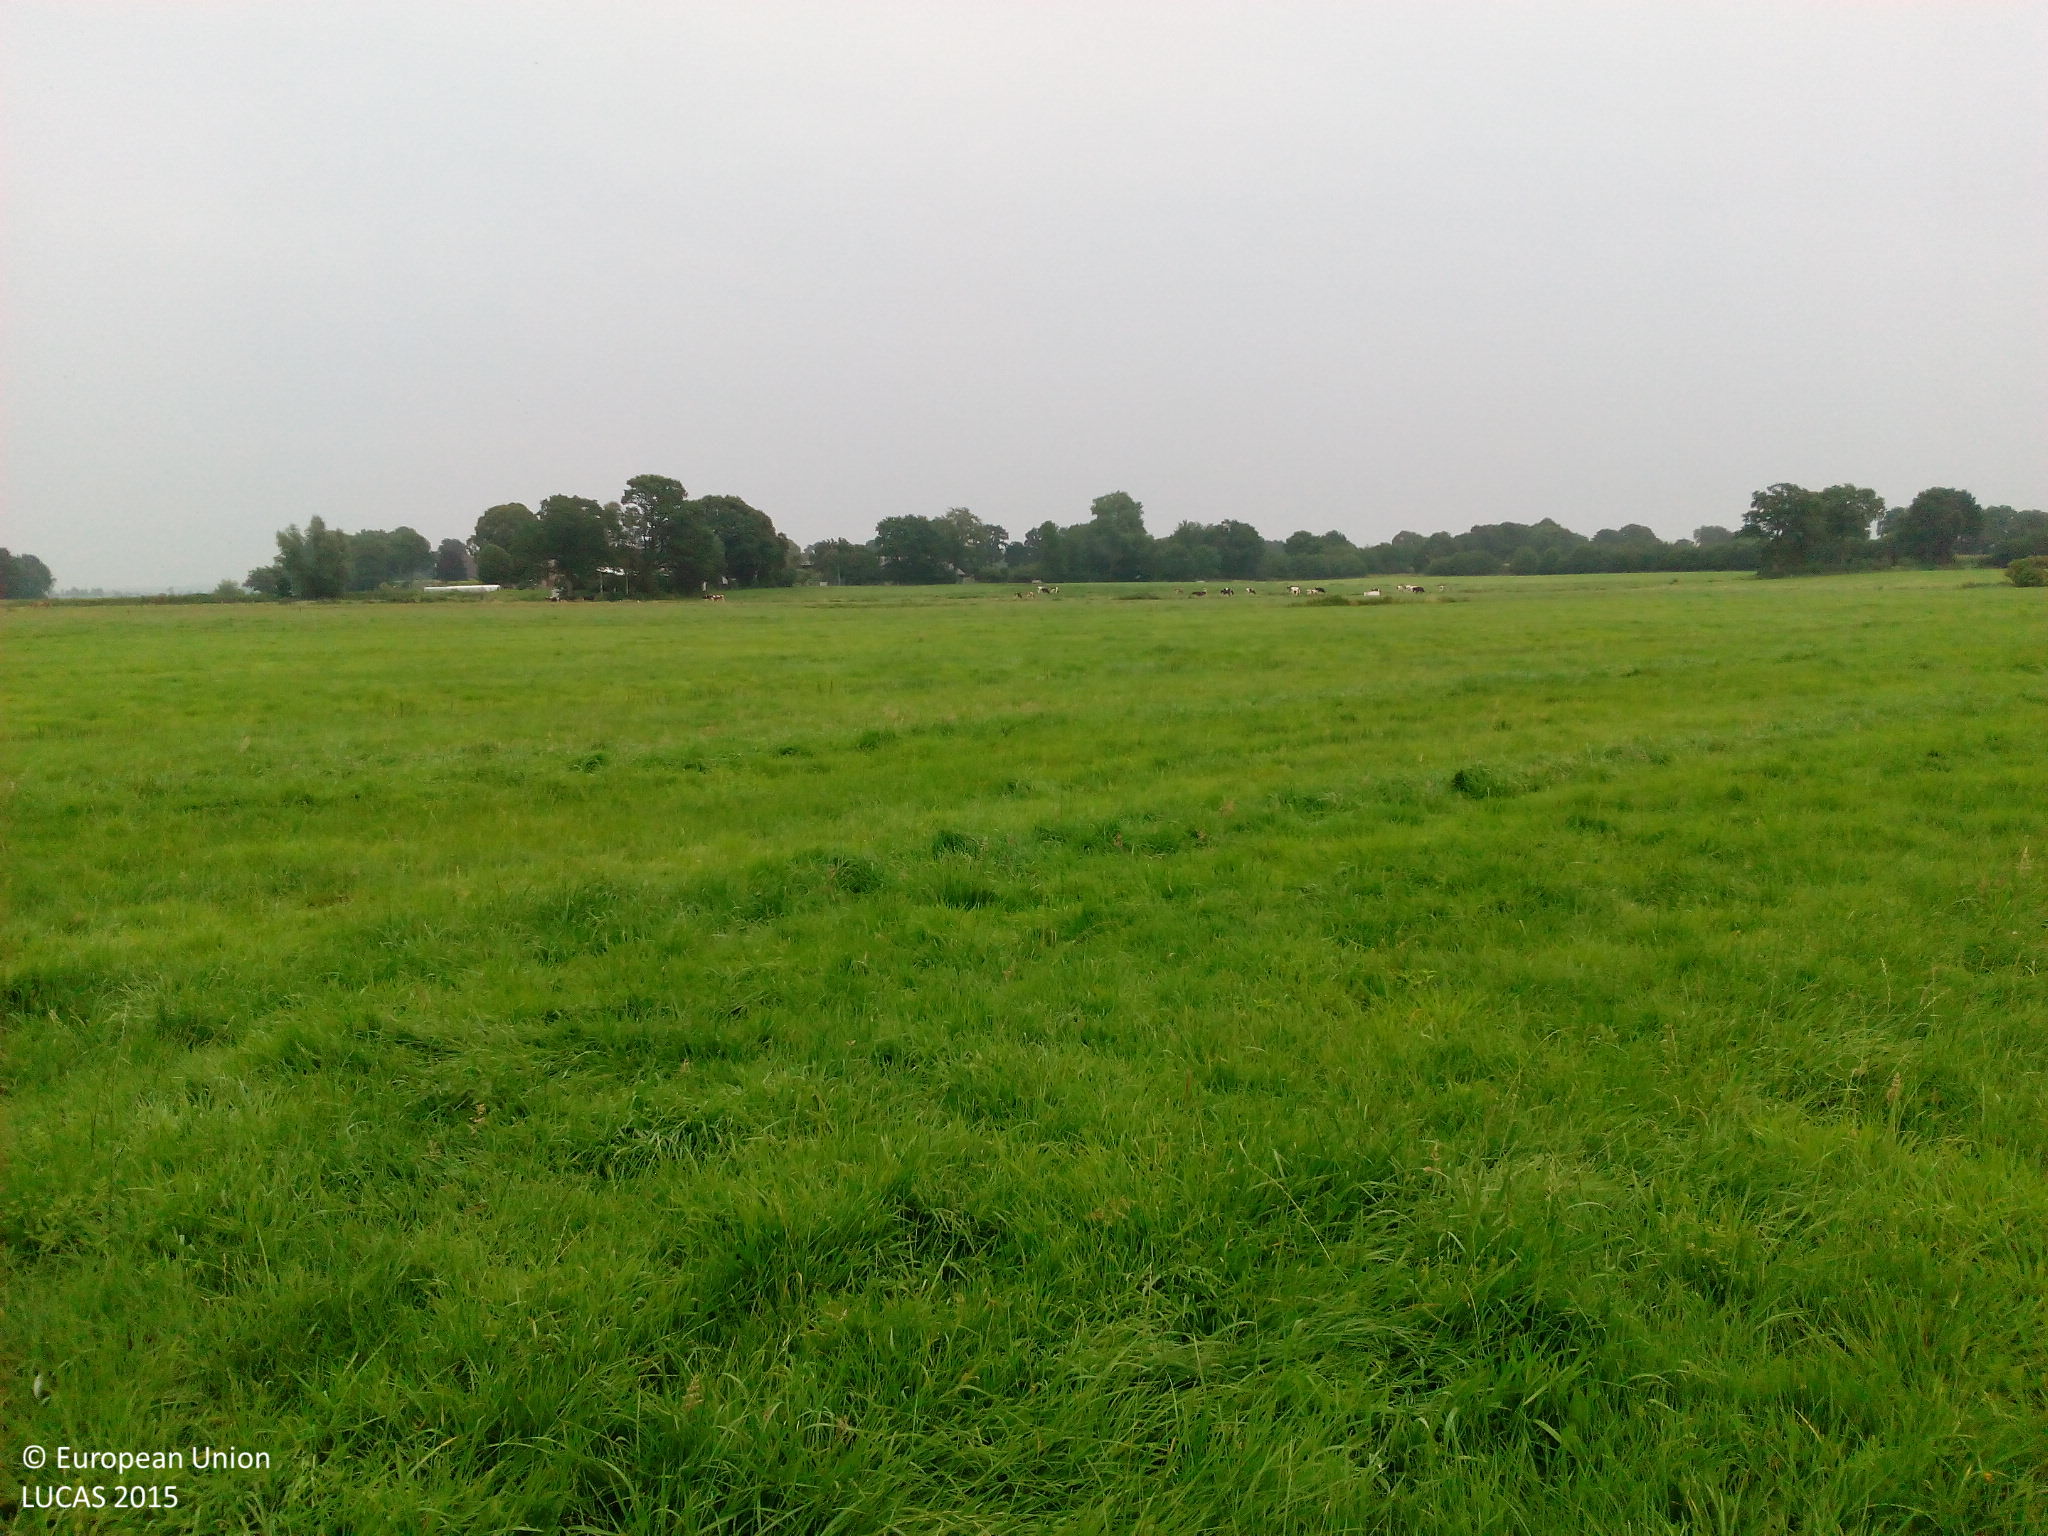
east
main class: Grassland
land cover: Grassland without tree/shrub cover
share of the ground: > 75 %
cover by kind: herbaceous plants 100 %
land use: Agriculture (excluding fallow land and kitchen gardens)
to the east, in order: Grassland without tree/shrub cover; Ditches and canals; Grassland without tree/shrub cover; Ditches and canals; Grassland without tree/shrub cover; Ditches and canals; Fences; Grassland without tree/shrub cover; Ditches and canals; Fences; Grassland without tree/shrub cover; Ditches and canals; Fences; Grassland without tree/shrub cover; Ditches and canals; Grassland without tree/shrub cover
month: August
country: DE
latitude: 53.8687
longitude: 9.6504
